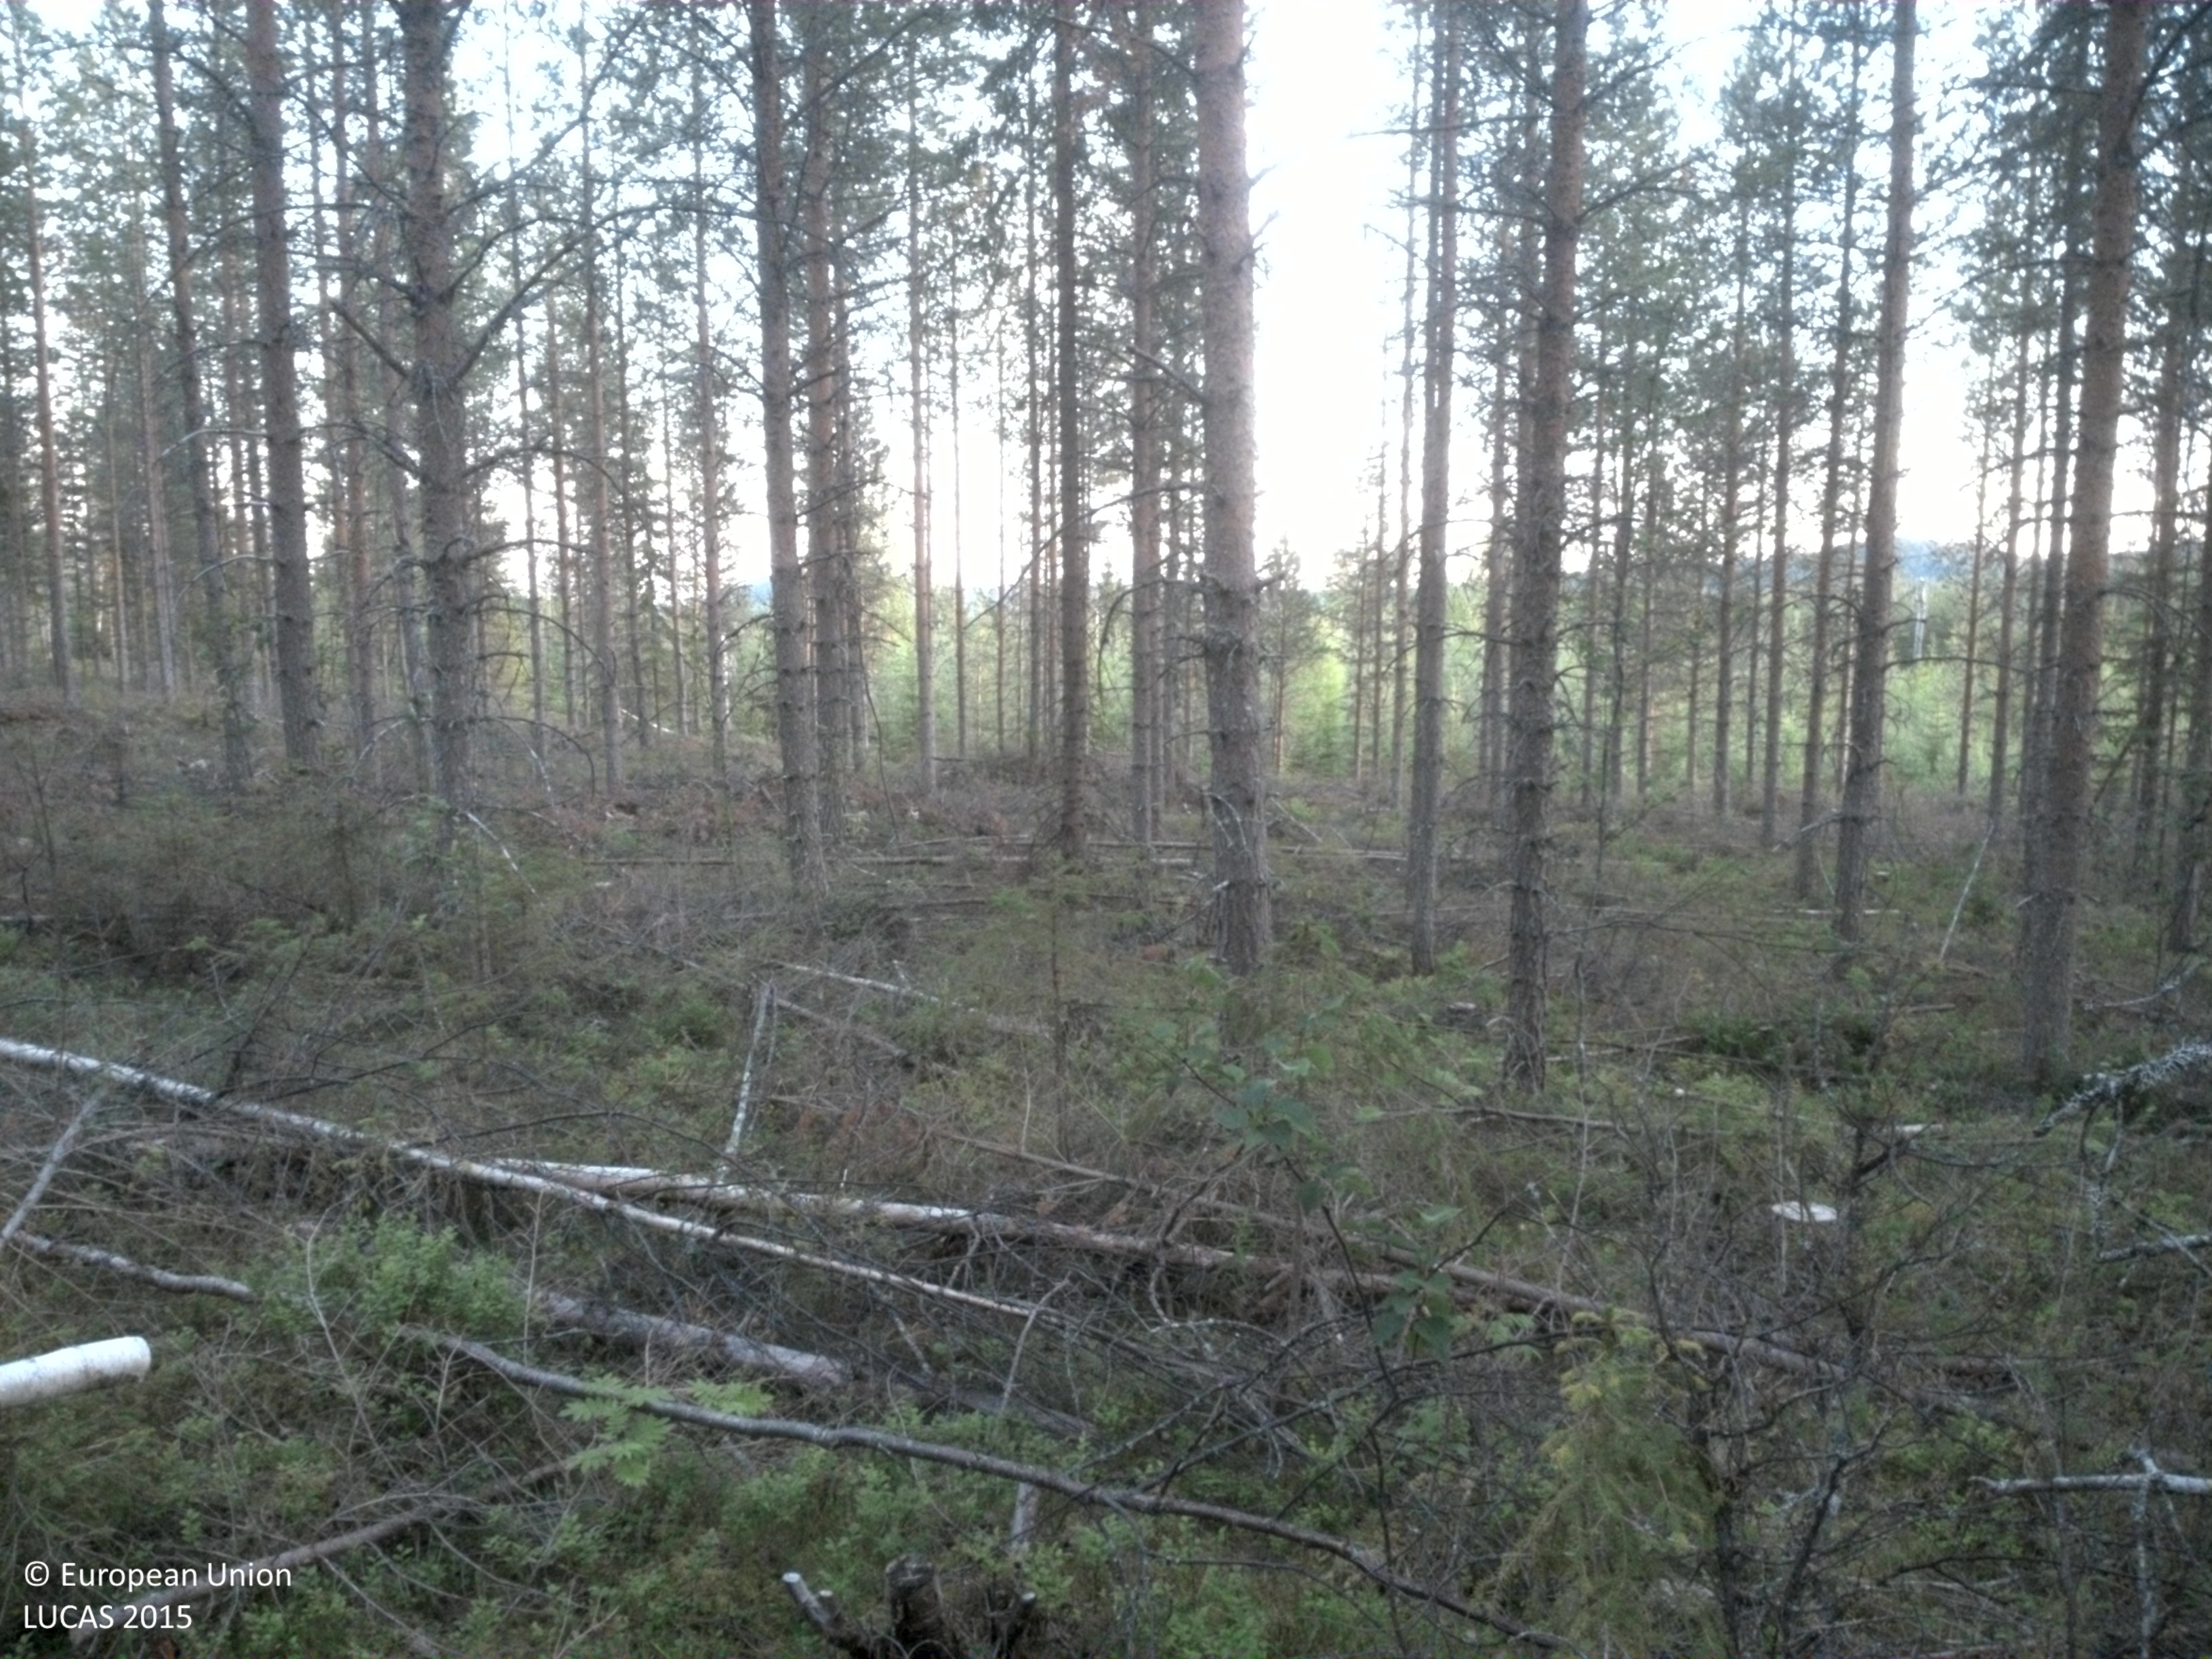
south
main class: Woodland
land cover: Pine dominated coniferous woodland
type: boreal forest
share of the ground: 50 - 75 %
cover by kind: coniferous forest trees 60 %, shrubs 30 %, herbaceous plants 5 %, lichens and mosses 5 %
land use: Forestry
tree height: > 5 m
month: August
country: SE
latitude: 64.6078
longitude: 18.4741
